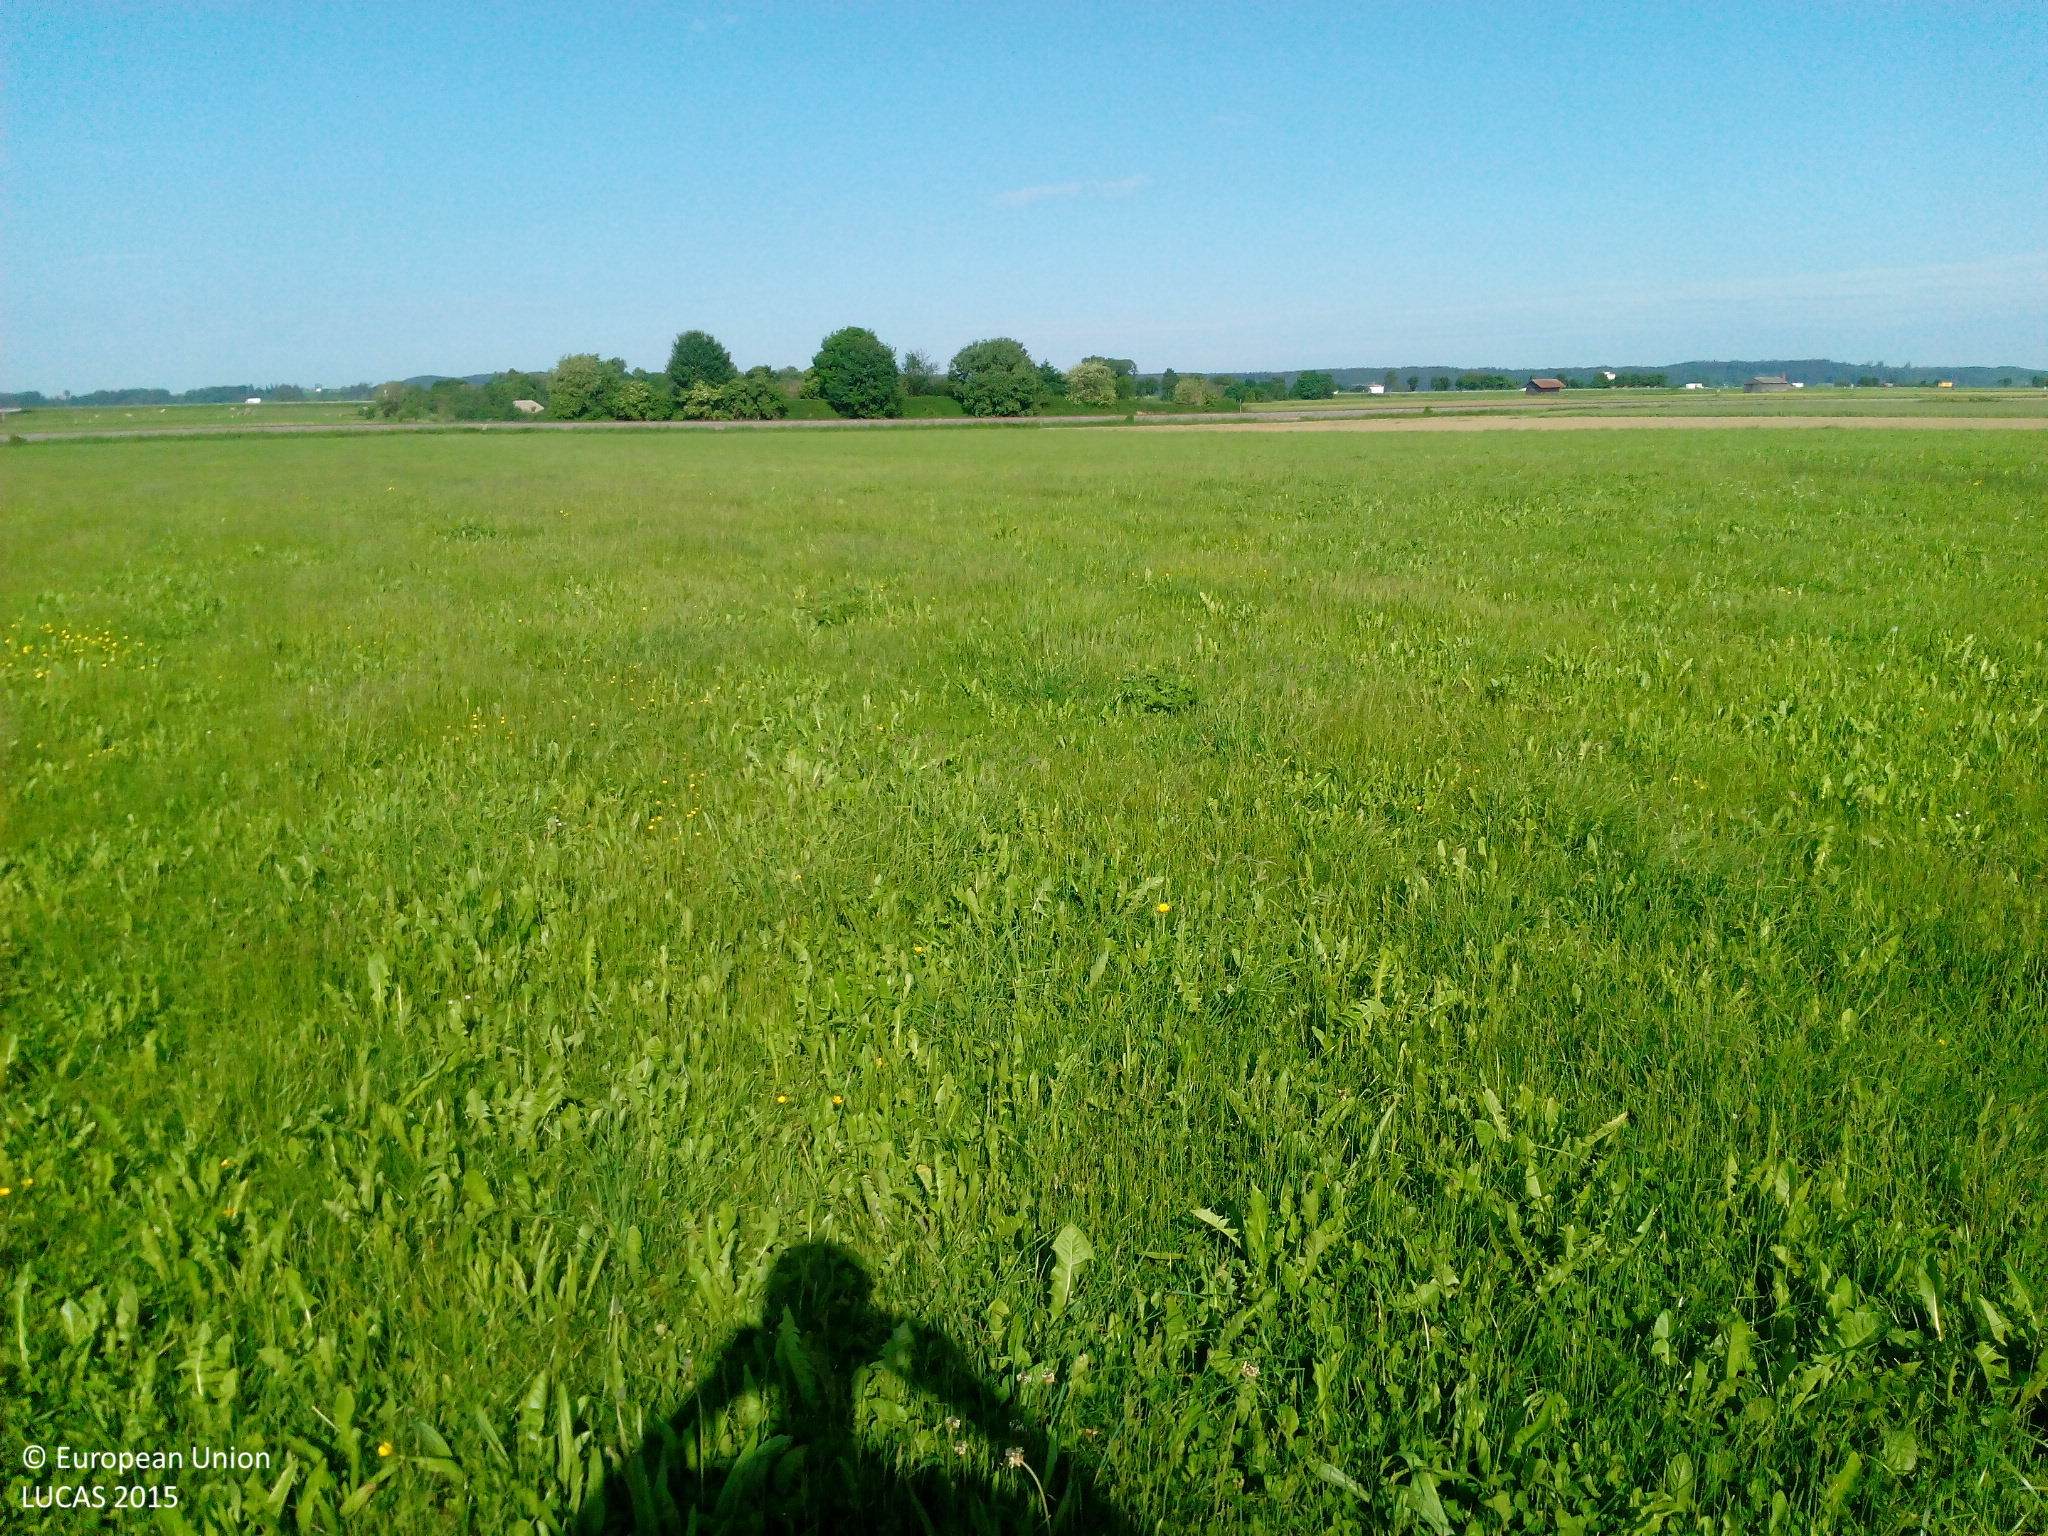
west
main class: Grassland
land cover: Grassland without tree/shrub cover
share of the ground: > 75 %
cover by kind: herbaceous plants 100 %
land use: Agriculture (excluding fallow land and kitchen gardens)
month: June
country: DE
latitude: 47.8993
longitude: 10.2540
